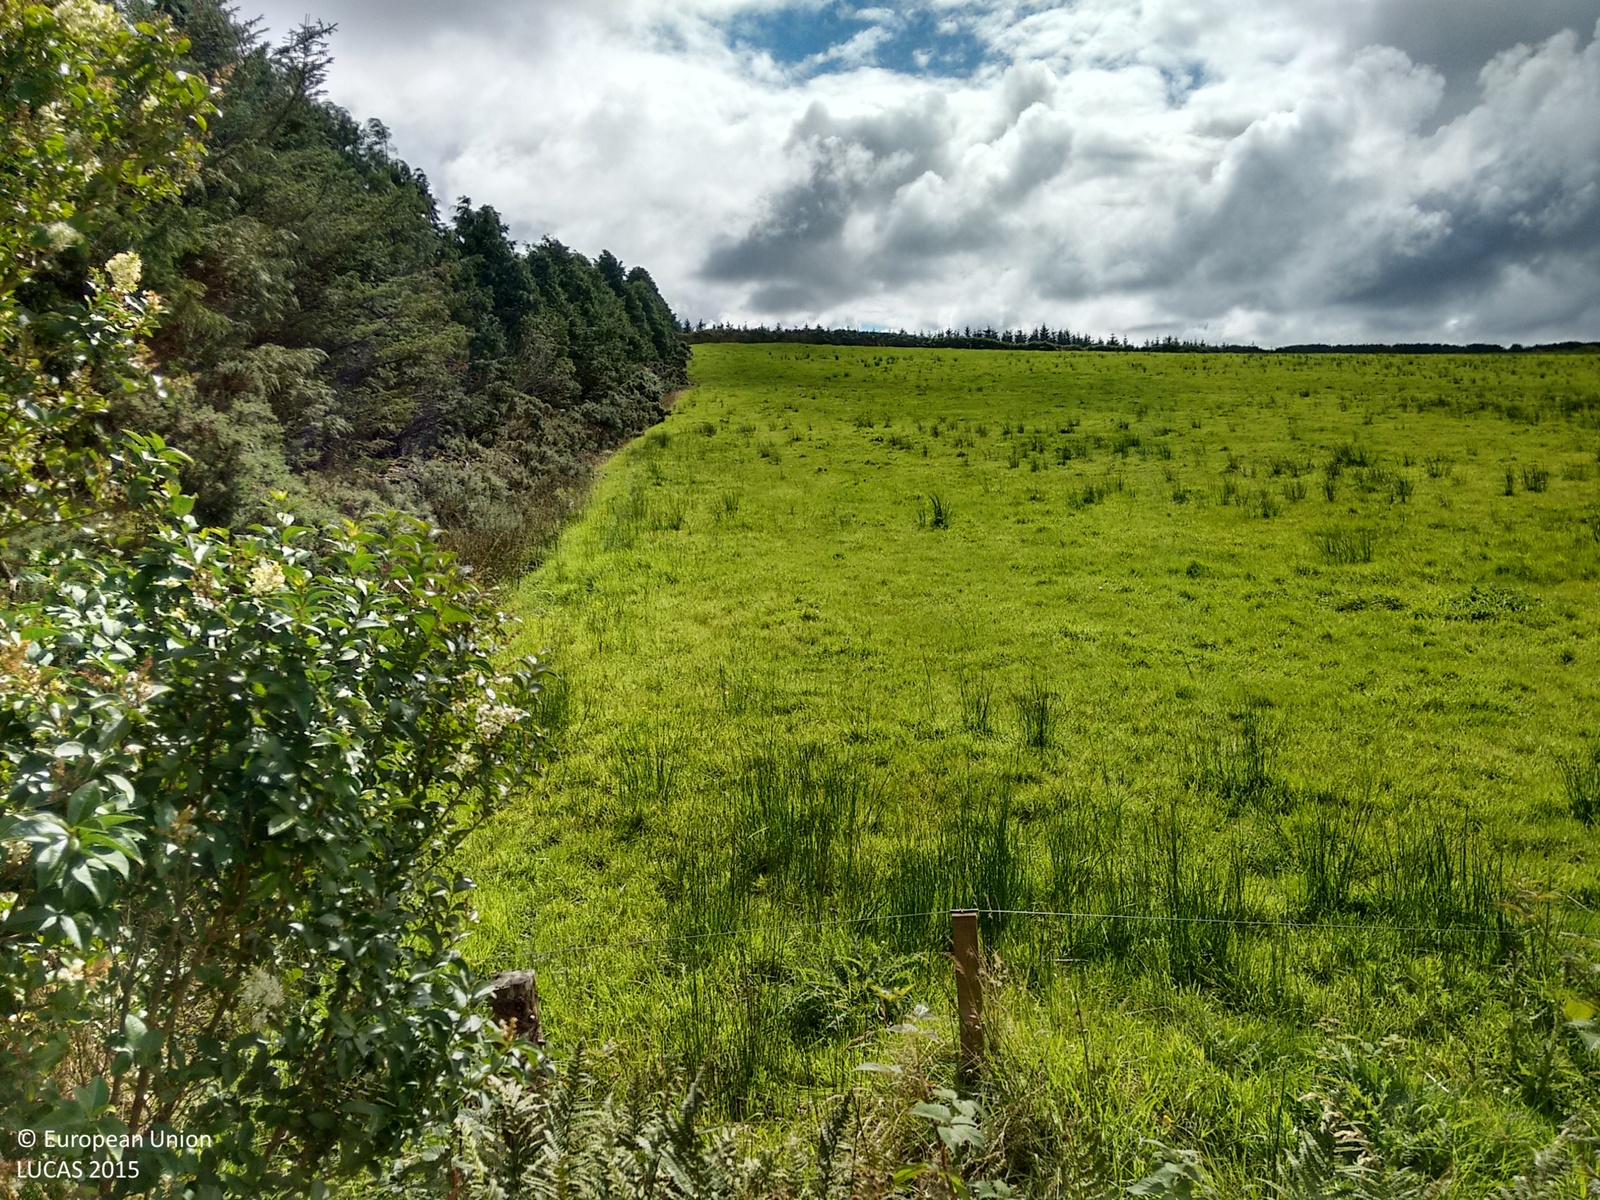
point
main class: Grassland
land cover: Grassland without tree/shrub cover
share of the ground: > 75 %
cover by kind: herbaceous plants 100 %
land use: Agriculture (excluding fallow land and kitchen gardens)
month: August
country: IE
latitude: 52.1720
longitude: -9.3374
